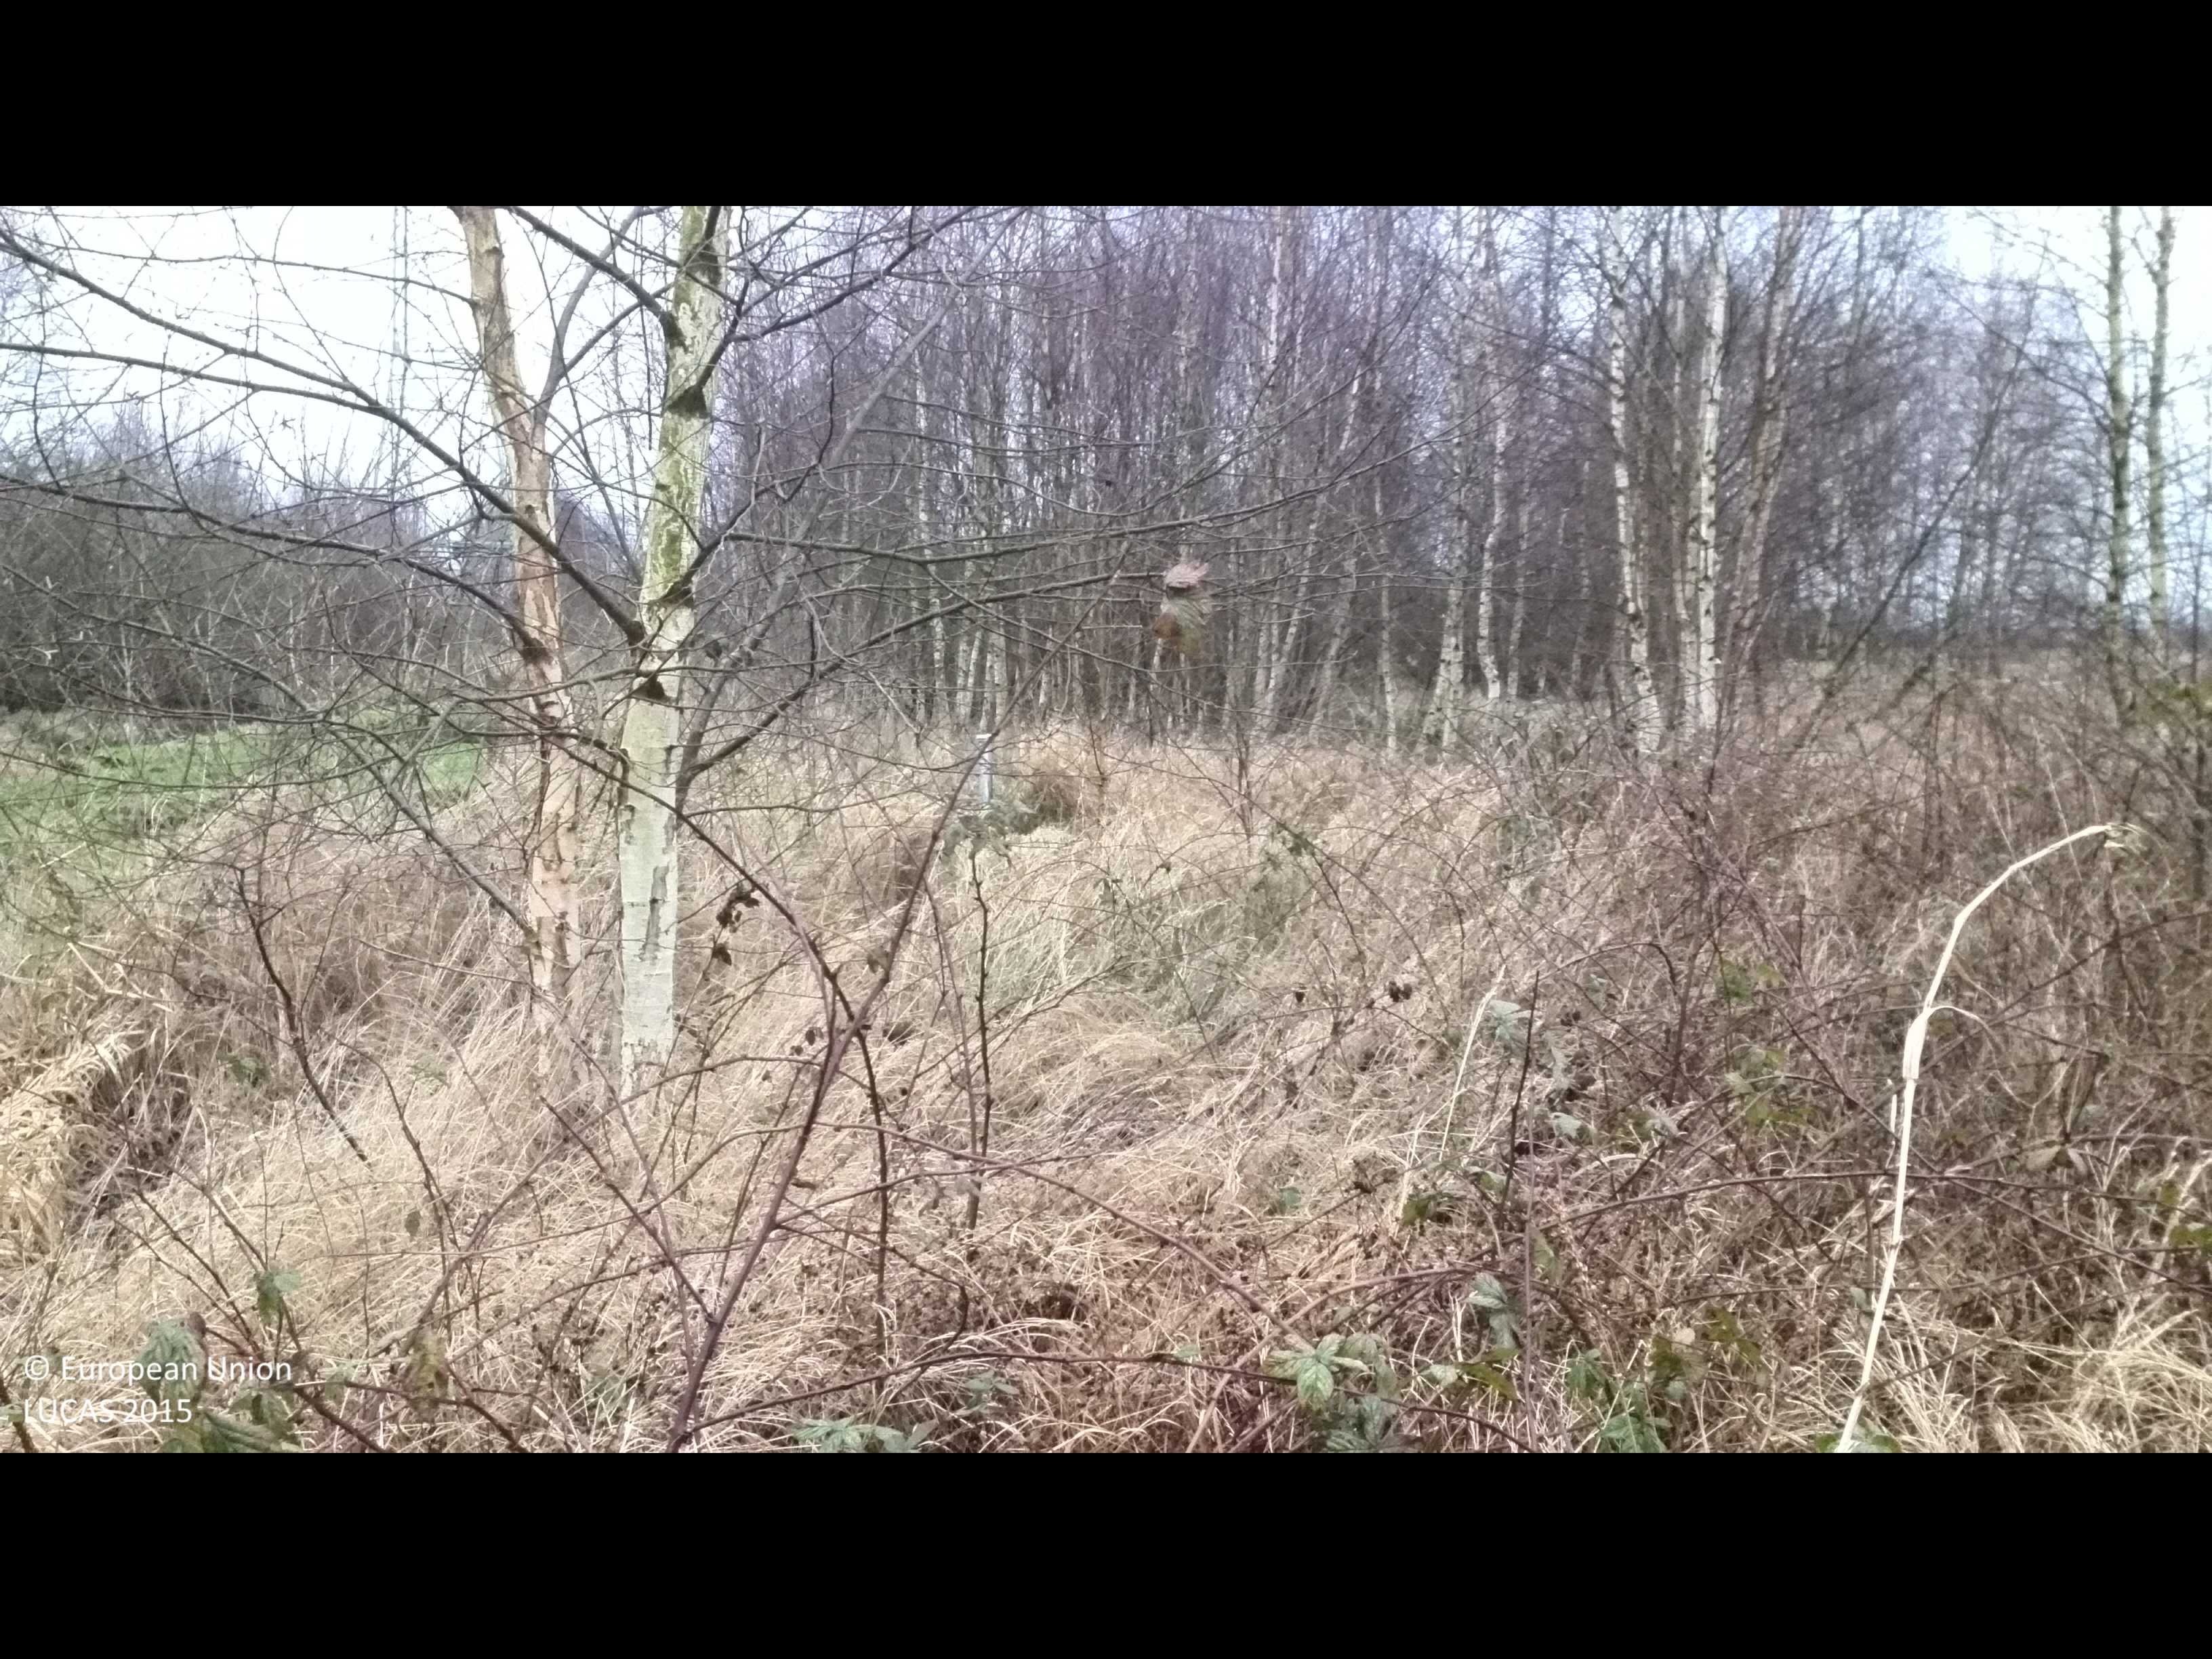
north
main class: Shrubland
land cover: Shrubland with sparse tree cover
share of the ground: > 75 %
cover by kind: shrubs 75 %, herbaceous plants 20 %, broadleaved forest trees 5 %
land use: Semi-natural and natural areas not in use
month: January
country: DE
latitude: 53.4917
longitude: 9.8343
